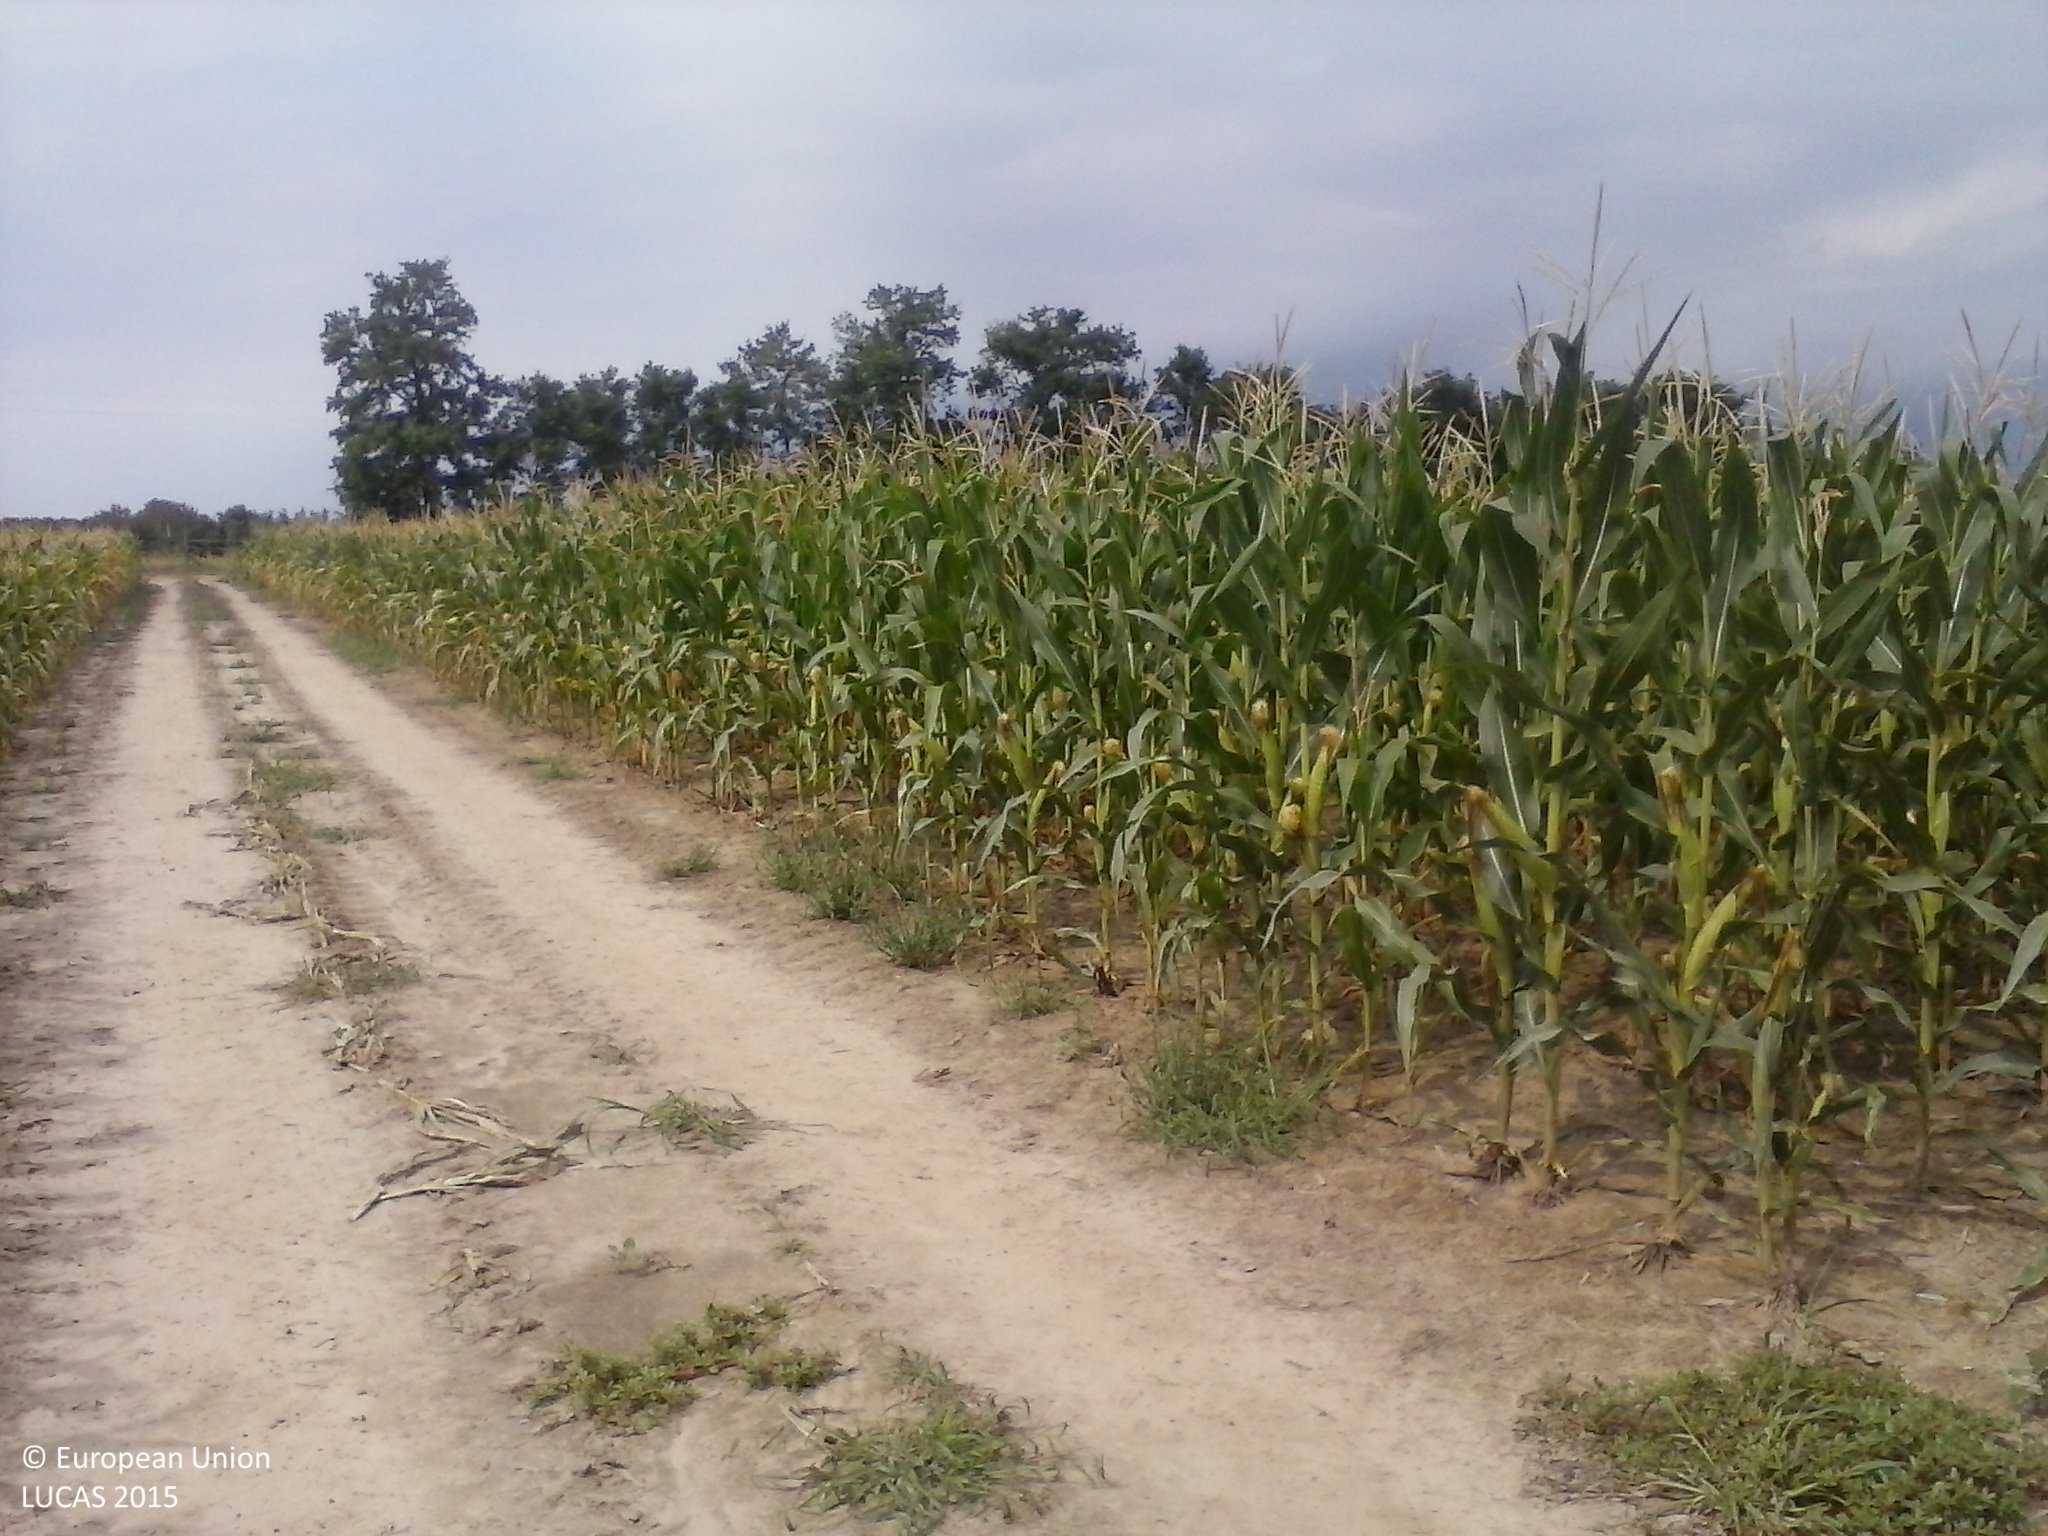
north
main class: Cropland
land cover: Maize
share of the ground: > 75 %
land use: Agriculture (excluding fallow land and kitchen gardens)
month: July
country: HU
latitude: 46.1026
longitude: 17.5457
